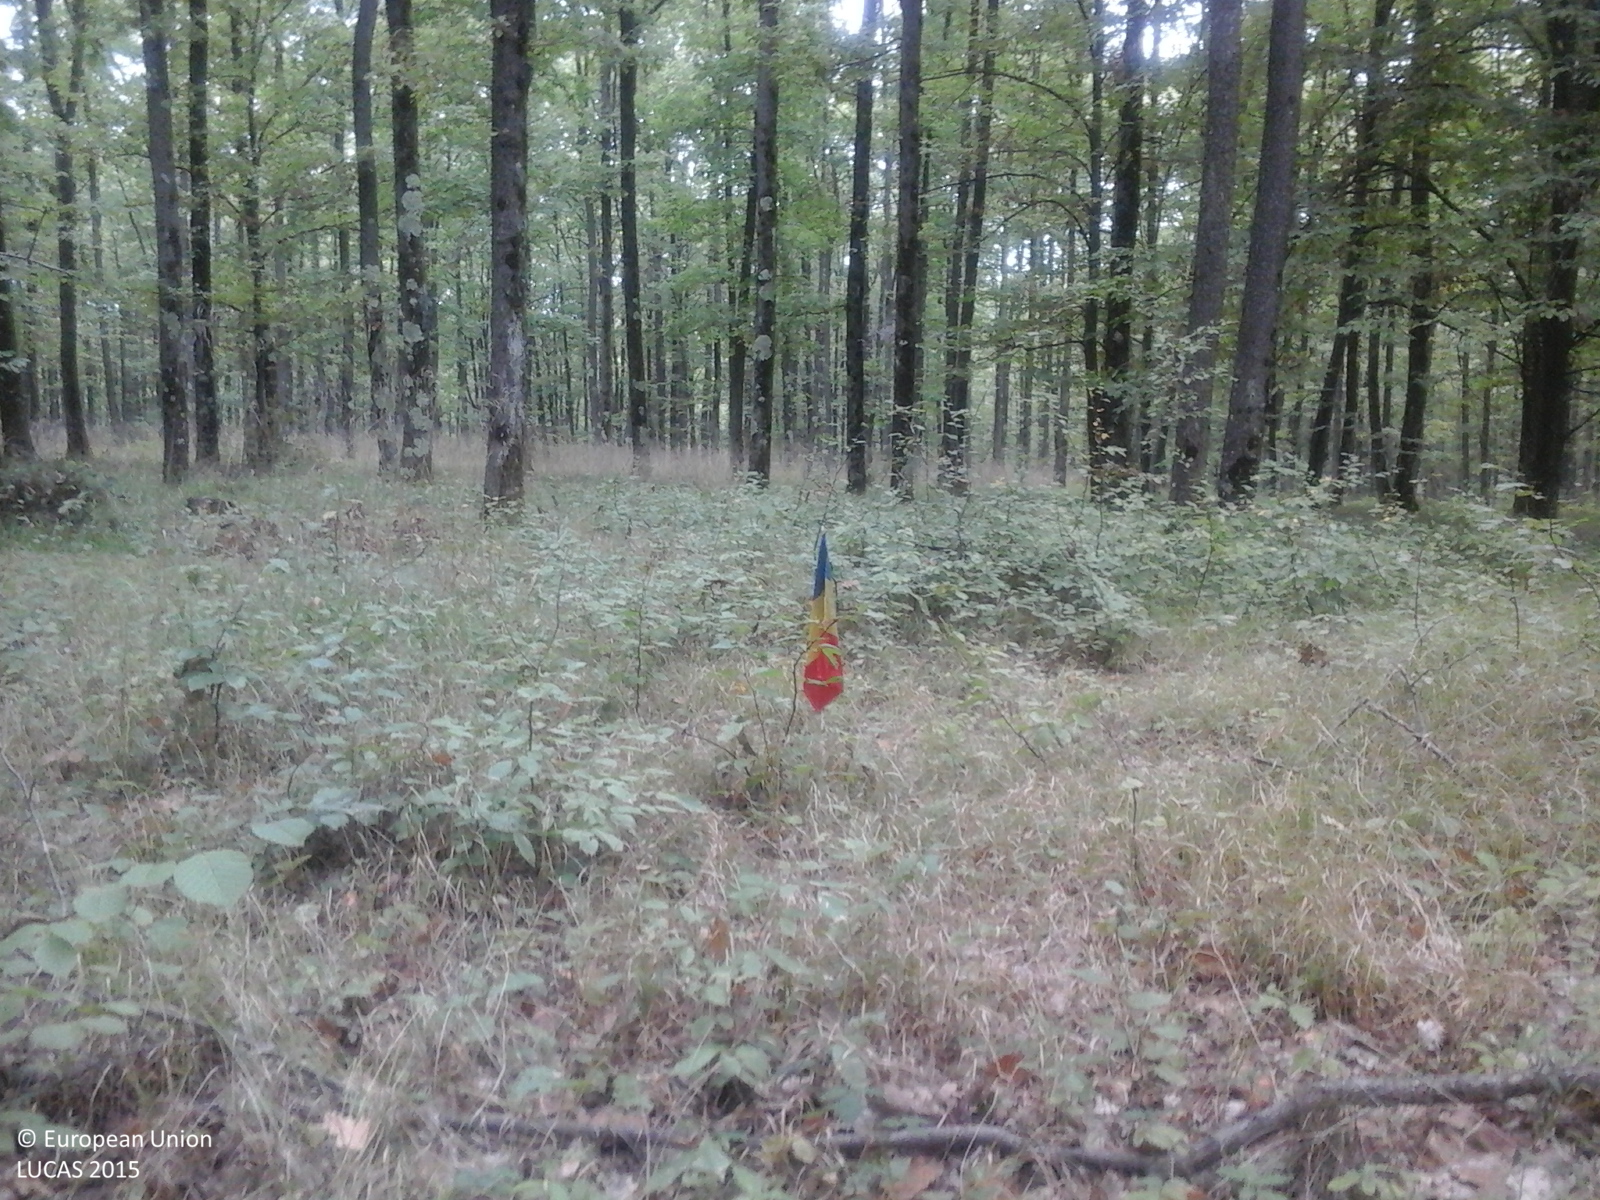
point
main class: Woodland
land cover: Broadleaved woodland
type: acidophilous oak and oak-birch forest
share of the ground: > 75 %
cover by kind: broadleaved forest trees 100 %
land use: Forestry
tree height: > 5 m
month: September
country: RO
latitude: 44.9475
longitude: 23.3240
